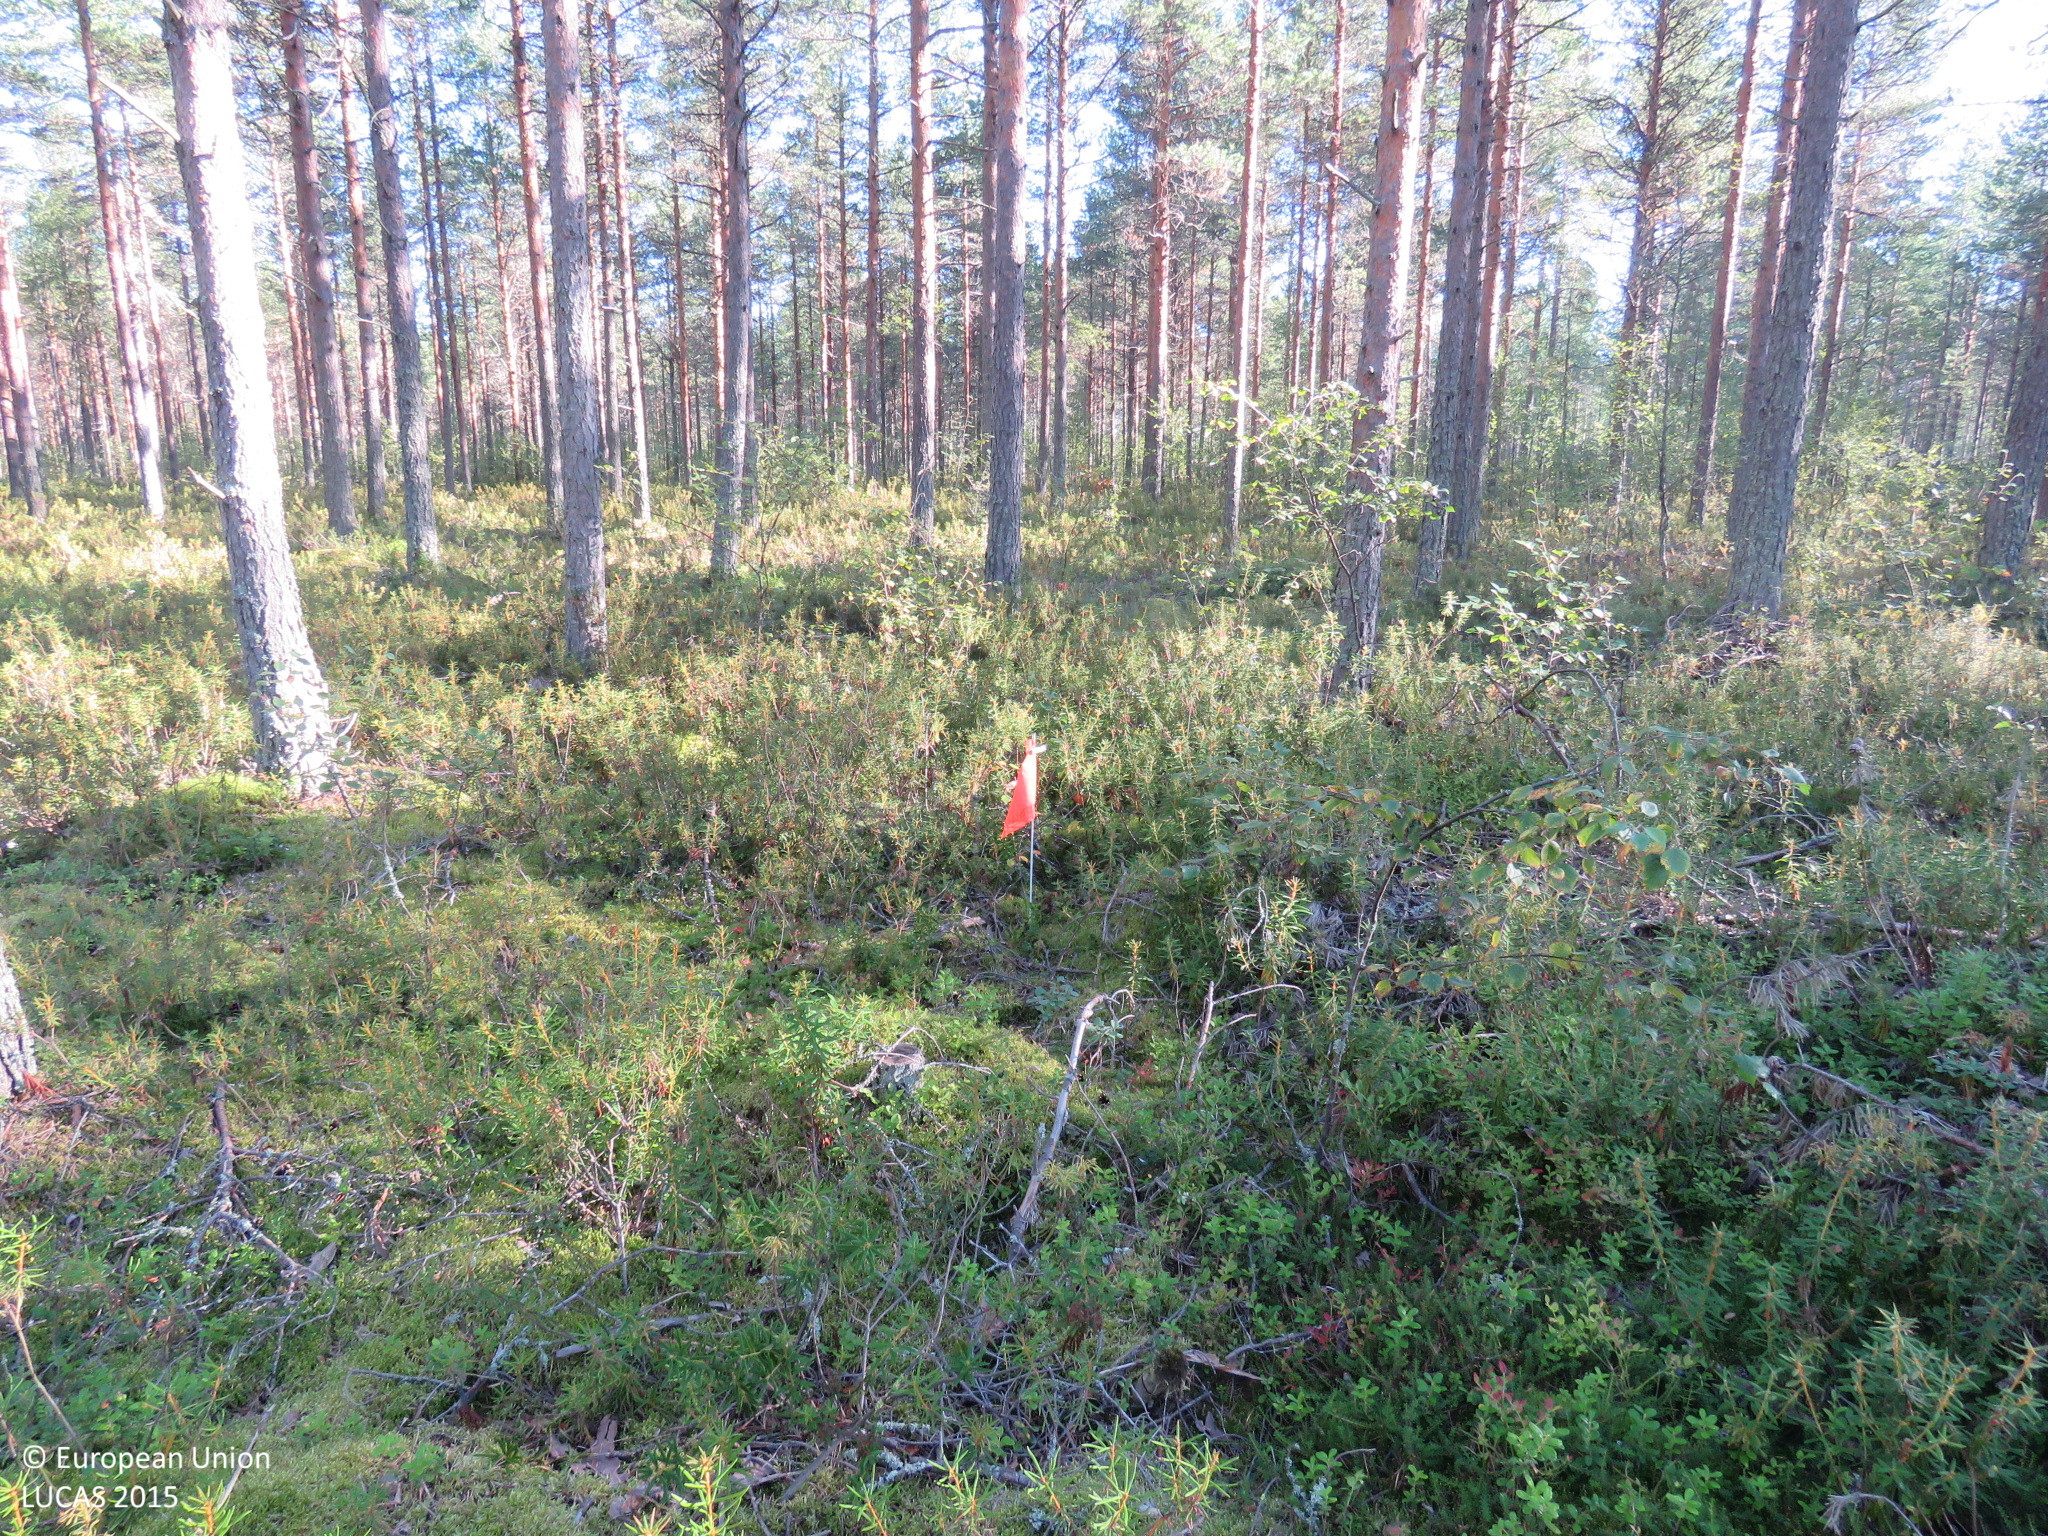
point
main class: Woodland
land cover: Pine dominated coniferous woodland
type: boreal forest
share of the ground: > 75 %
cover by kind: coniferous forest trees 60 %, shrubs 20 %, broadleaved forest trees 15 %, lichens and mosses 5 %
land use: Forestry
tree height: > 5 m
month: August
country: FI
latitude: 64.9842
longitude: 24.6695
